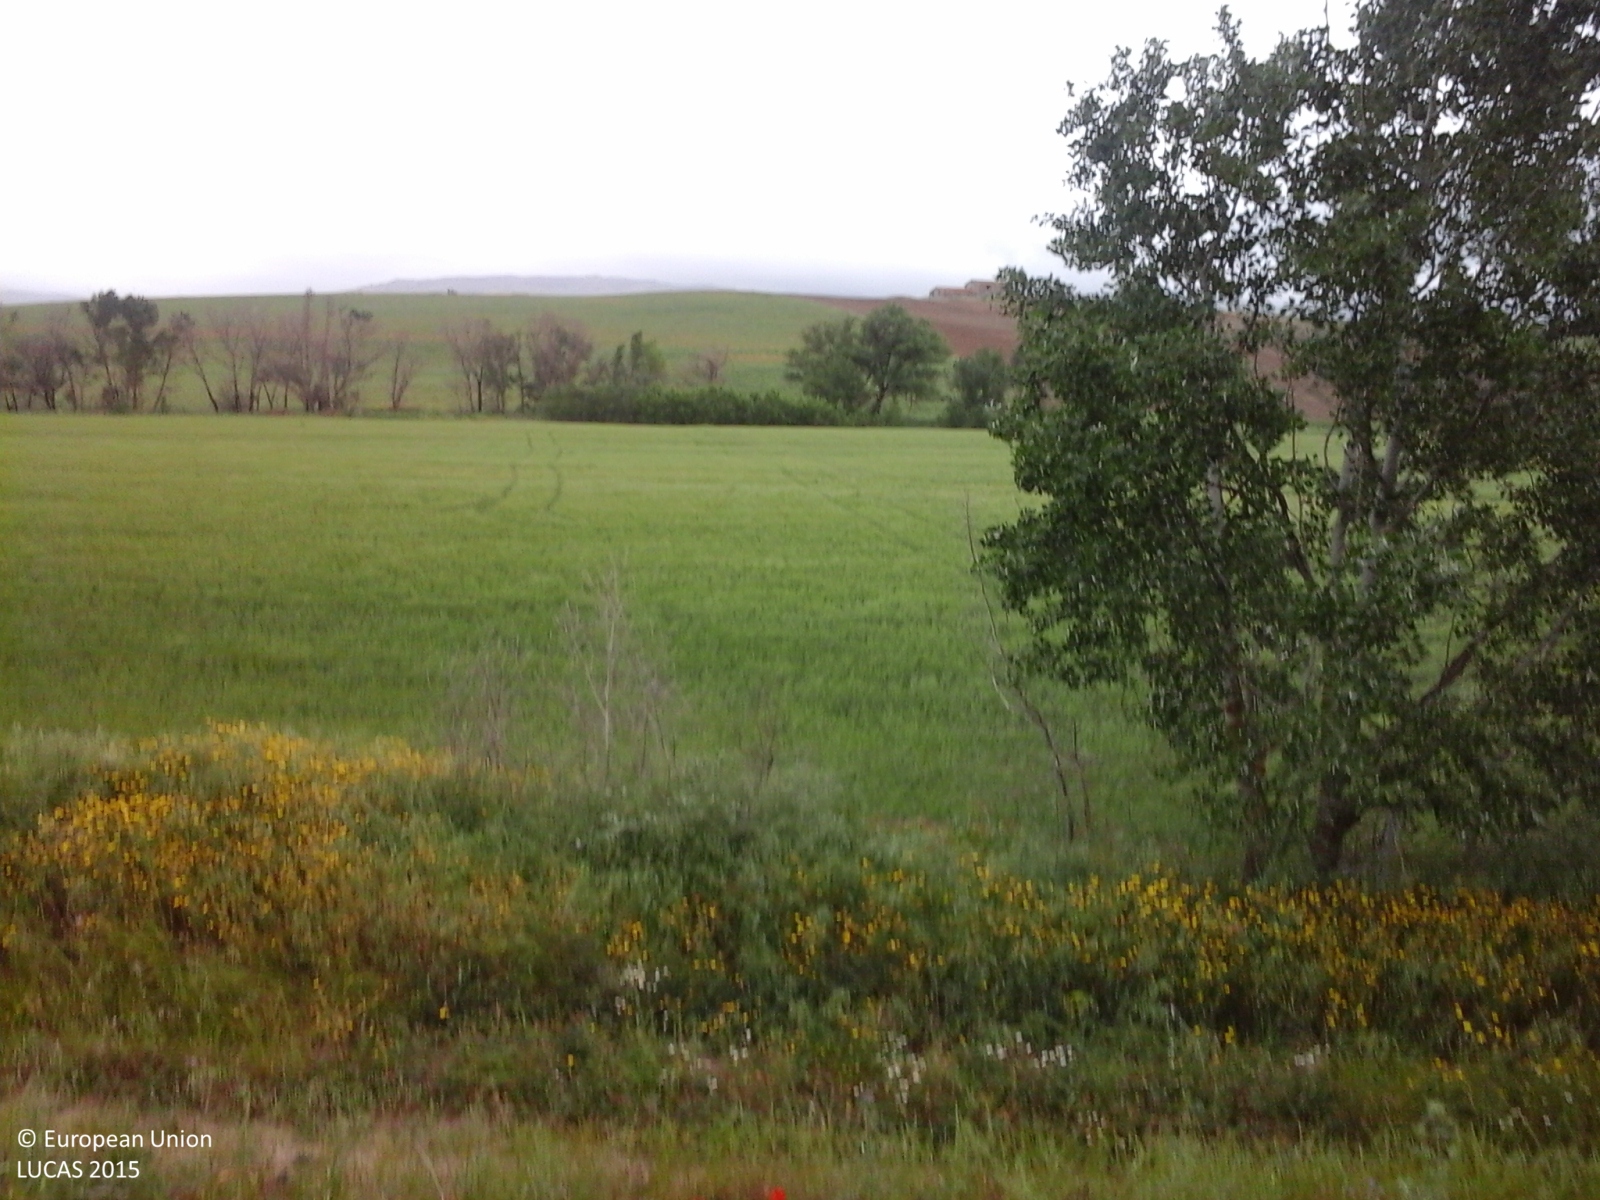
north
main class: Cropland
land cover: Durum wheat
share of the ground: > 75 %
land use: Agriculture (excluding fallow land and kitchen gardens)
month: May
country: IT
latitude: 37.7099
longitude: 13.7499
